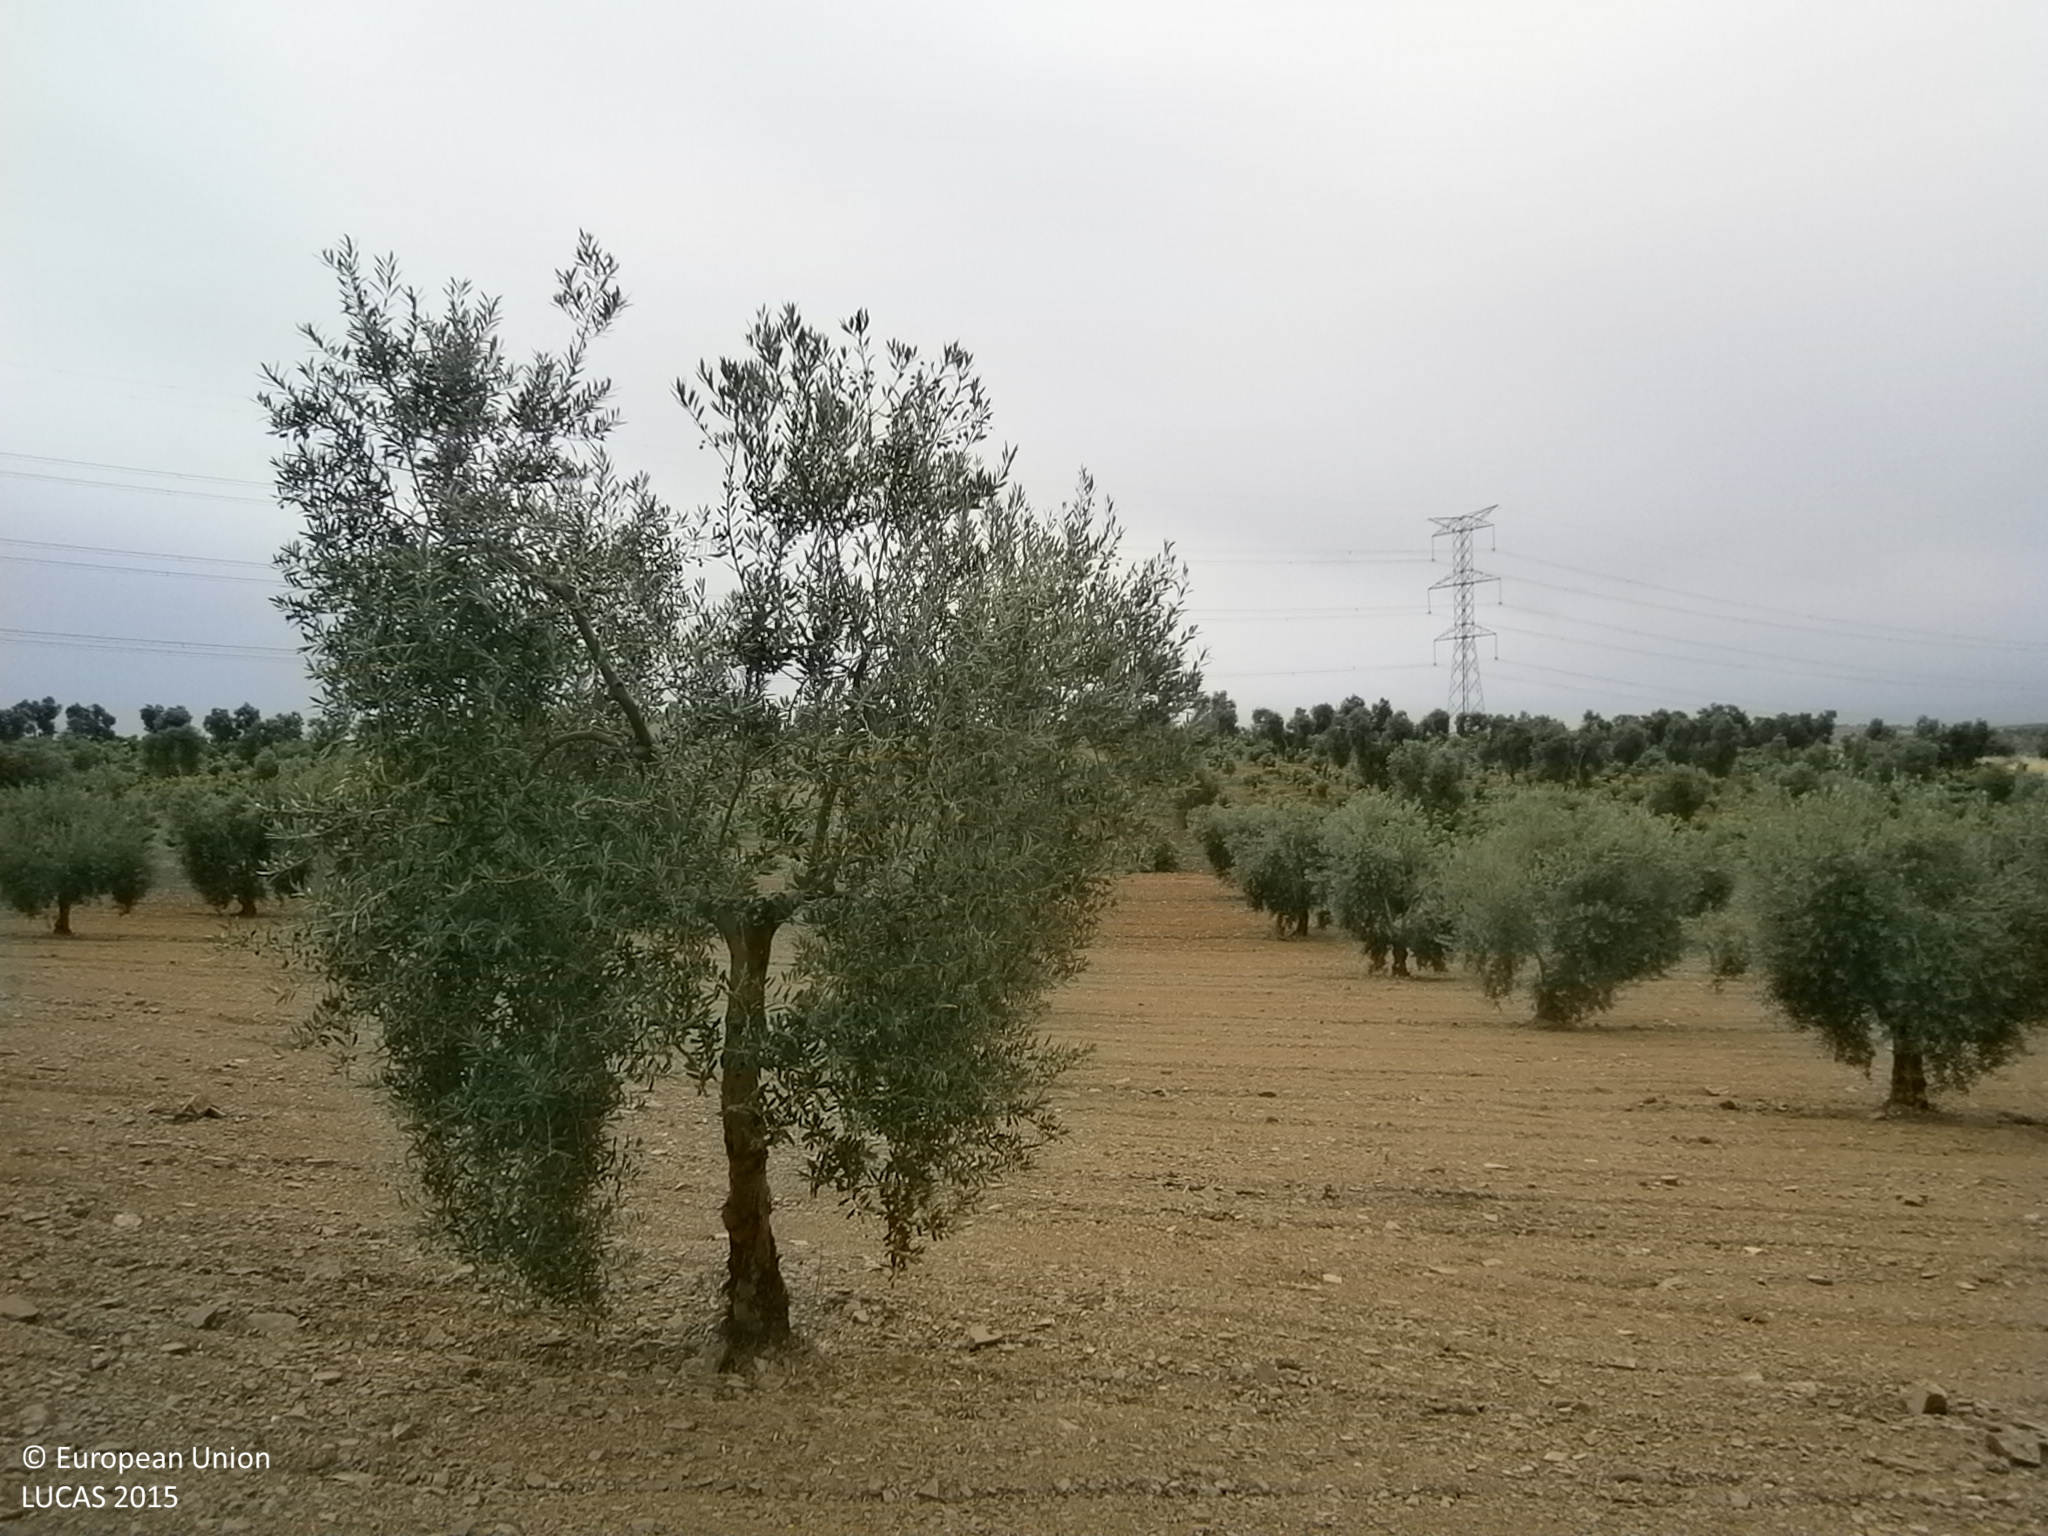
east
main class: Cropland
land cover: Olive groves
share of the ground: 10 - 25 %
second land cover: Other bare soil
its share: > 75 %
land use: Agriculture (excluding fallow land and kitchen gardens)
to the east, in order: Olive groves; Other bare soil; Tracks; Vineyards; Olive groves; Other bare soil; Vineyards; Other bare soil; Electric lines; Olive groves; Vineyards
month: June
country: ES
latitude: 38.5899
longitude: -6.4600
